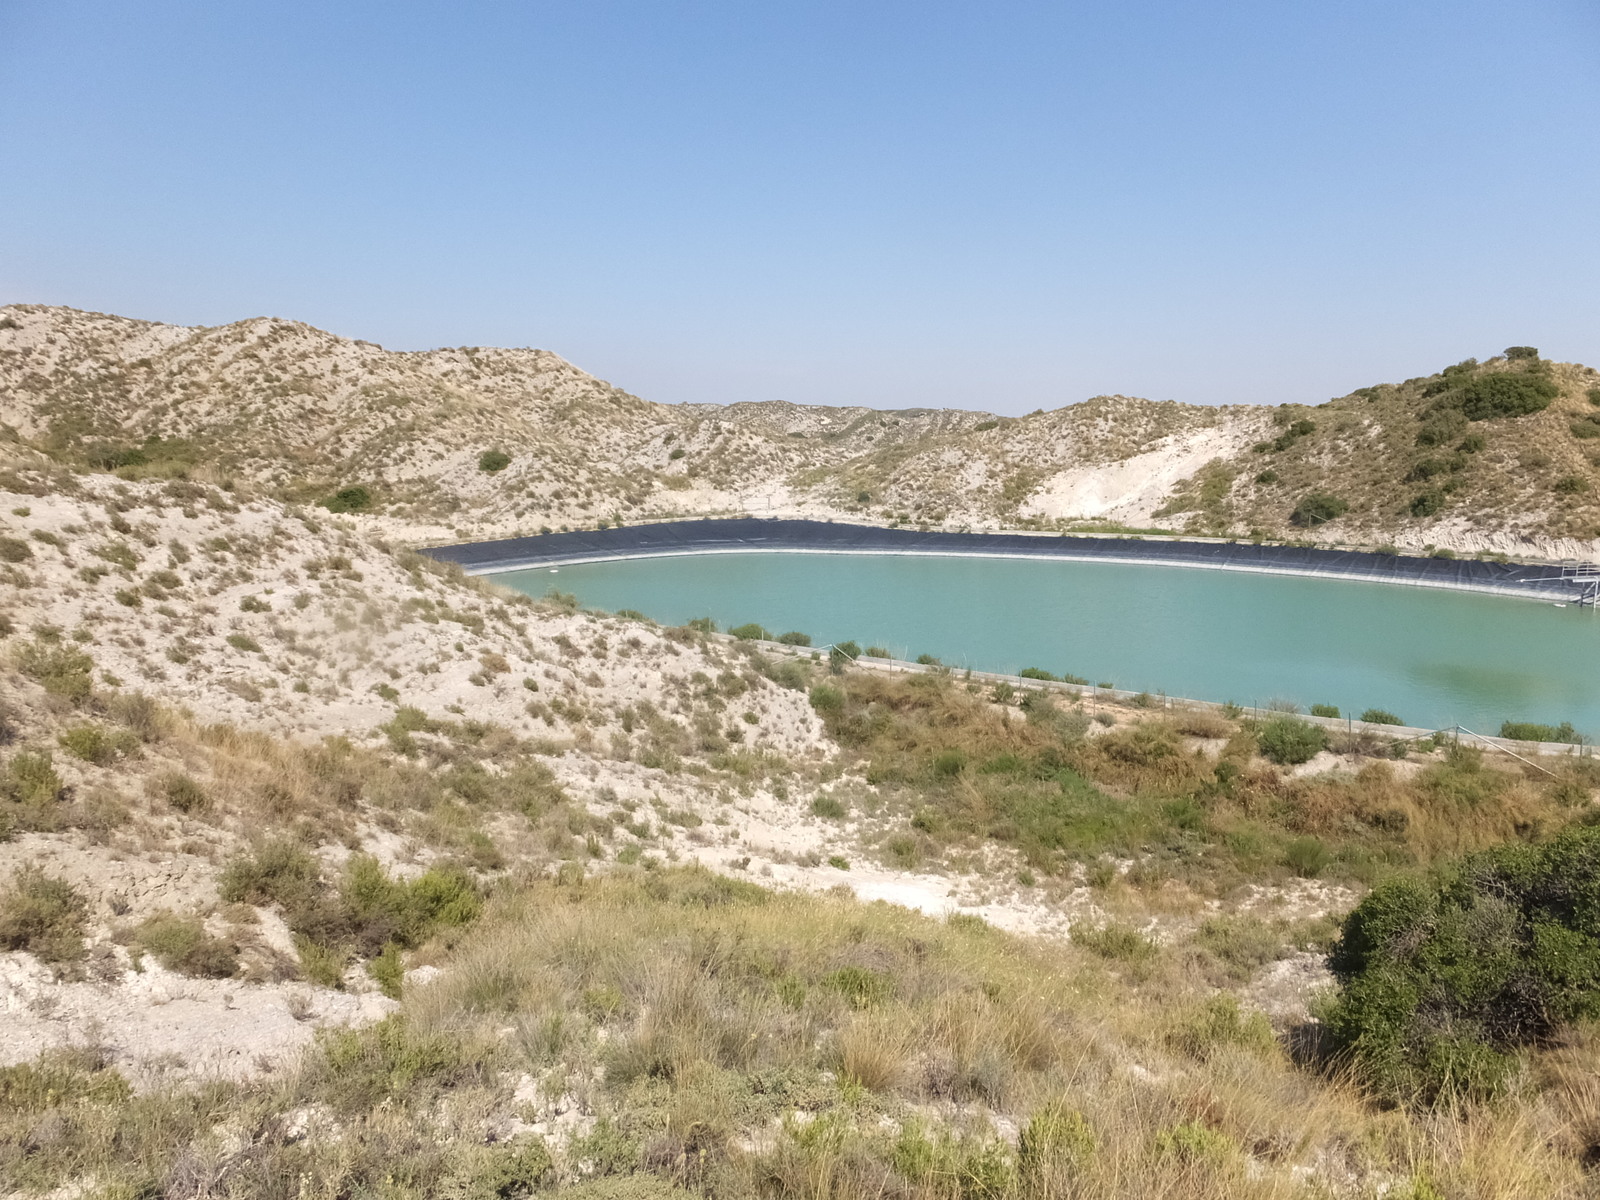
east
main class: Shrubland
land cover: Shrubland without tree cover
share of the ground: 50 - 75 %
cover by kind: shrubs 50 %, herbaceous plants 25 %, consolidated bare surface 25 %
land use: Semi-natural and natural areas not in use
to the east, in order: Shrubland without tree cover; Rocks and stones; Fences; Tracks; Inland fresh water bodies; Tracks; Fences; Rocks and stones; Shrubland without tree cover
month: June
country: ES
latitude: 41.8460
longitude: 0.5311
